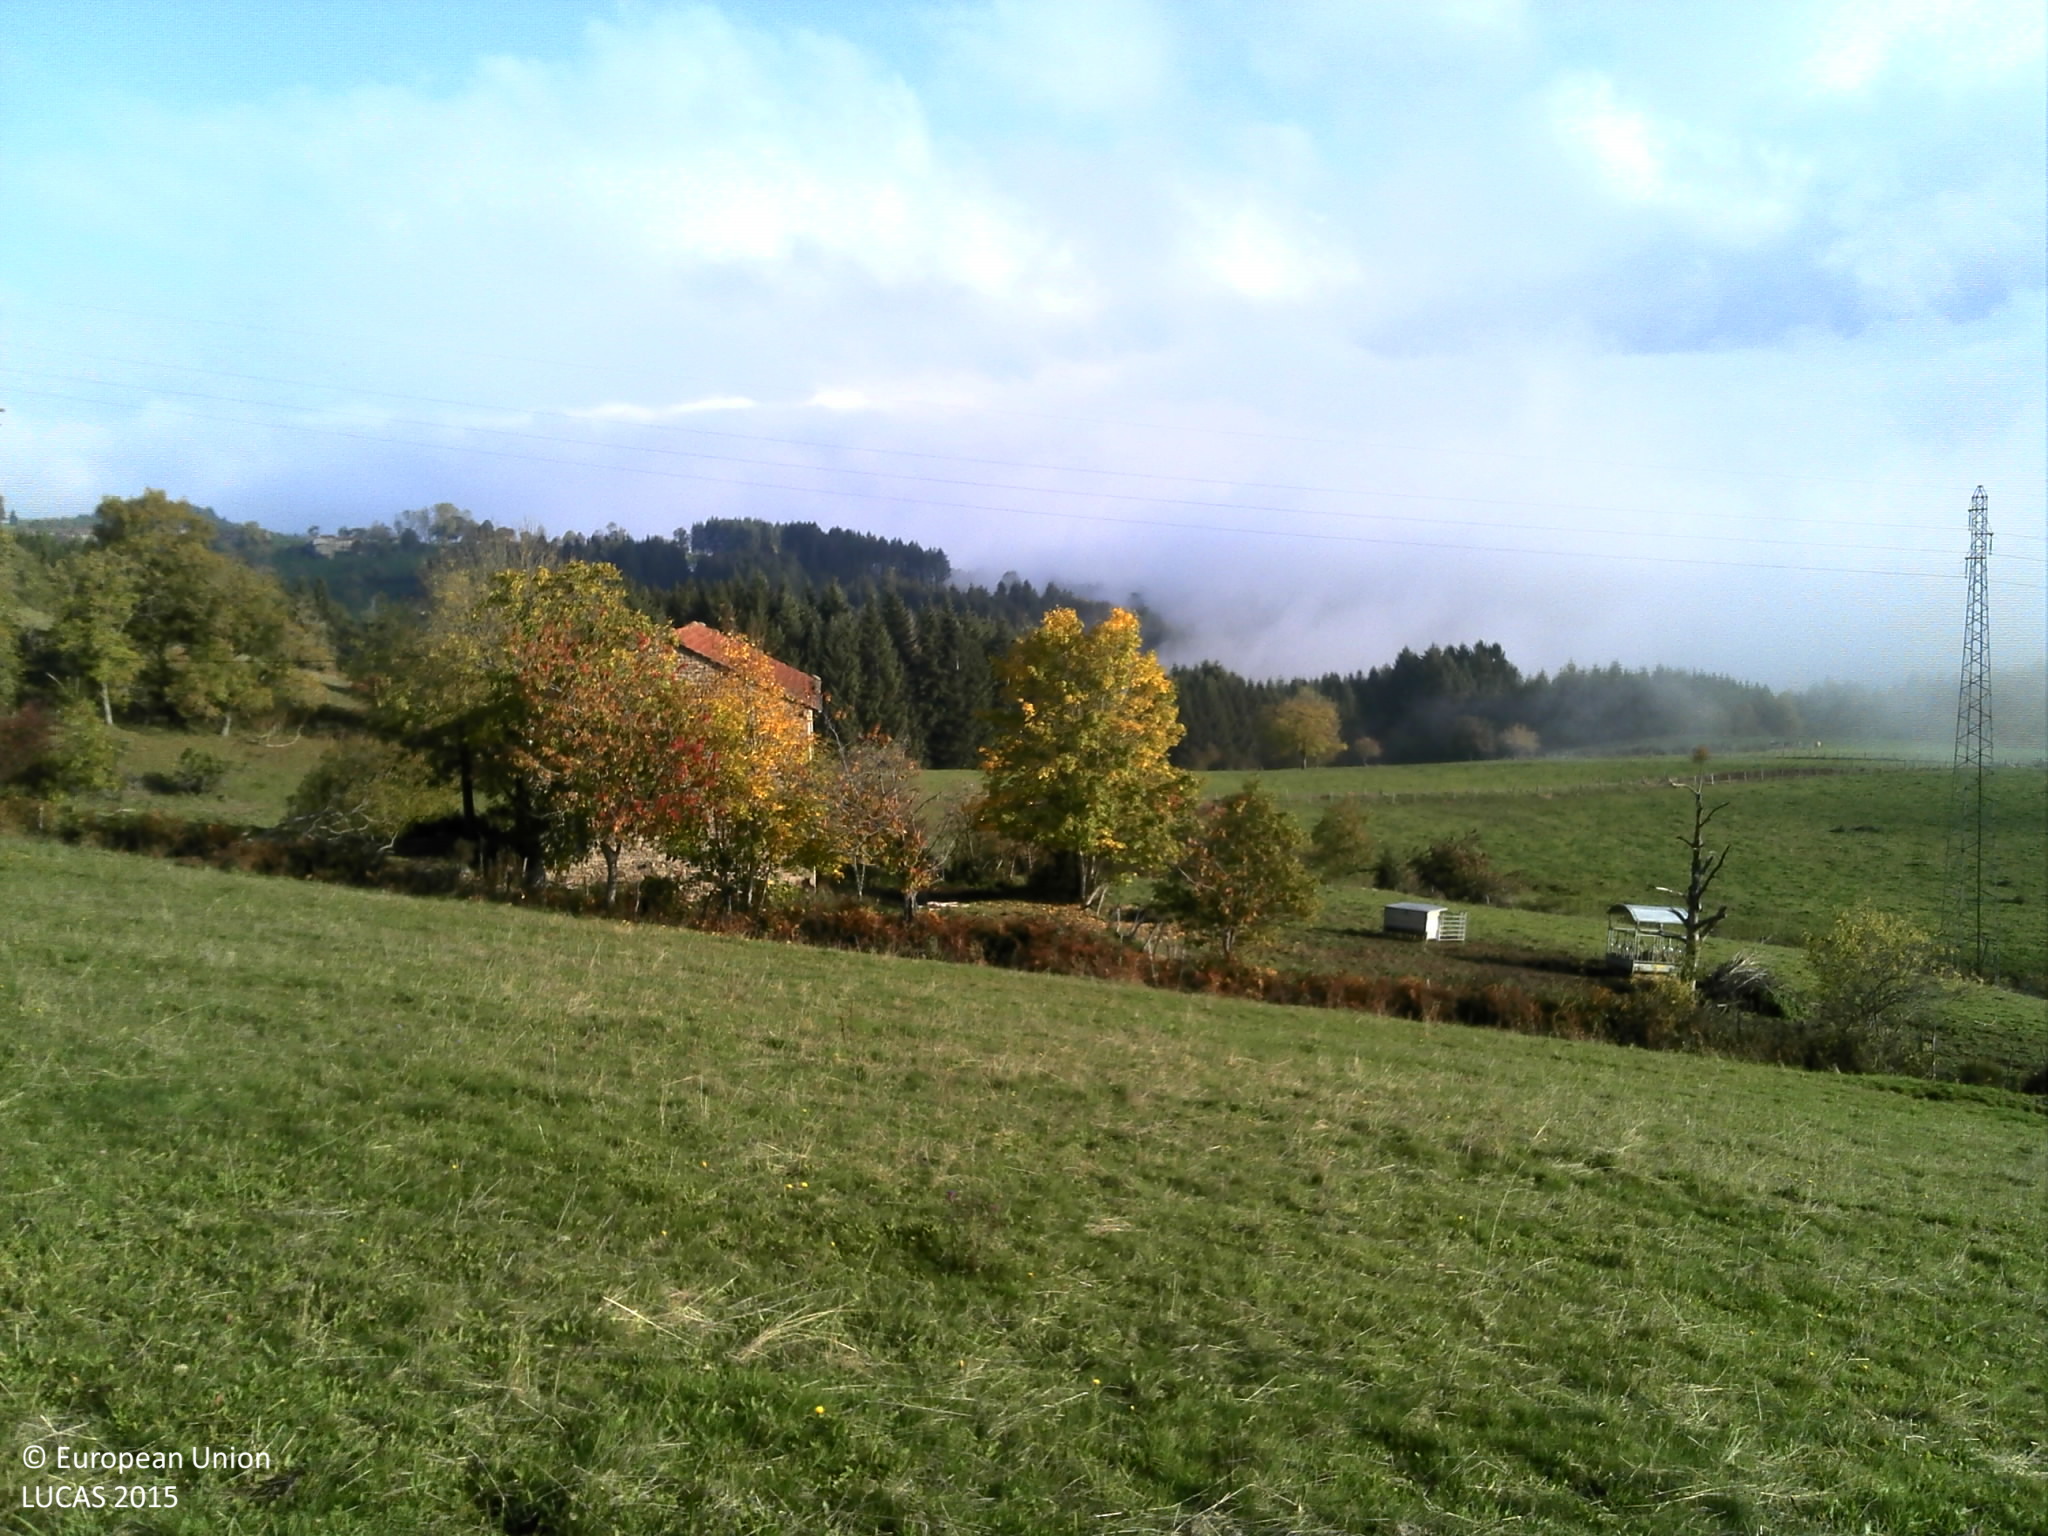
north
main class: Grassland
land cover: Grassland without tree/shrub cover
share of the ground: > 75 %
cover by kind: herbaceous plants 100 %
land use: Agriculture (excluding fallow land and kitchen gardens)
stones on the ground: < 10 %
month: October
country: FR
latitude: 45.5878
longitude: 3.7086
